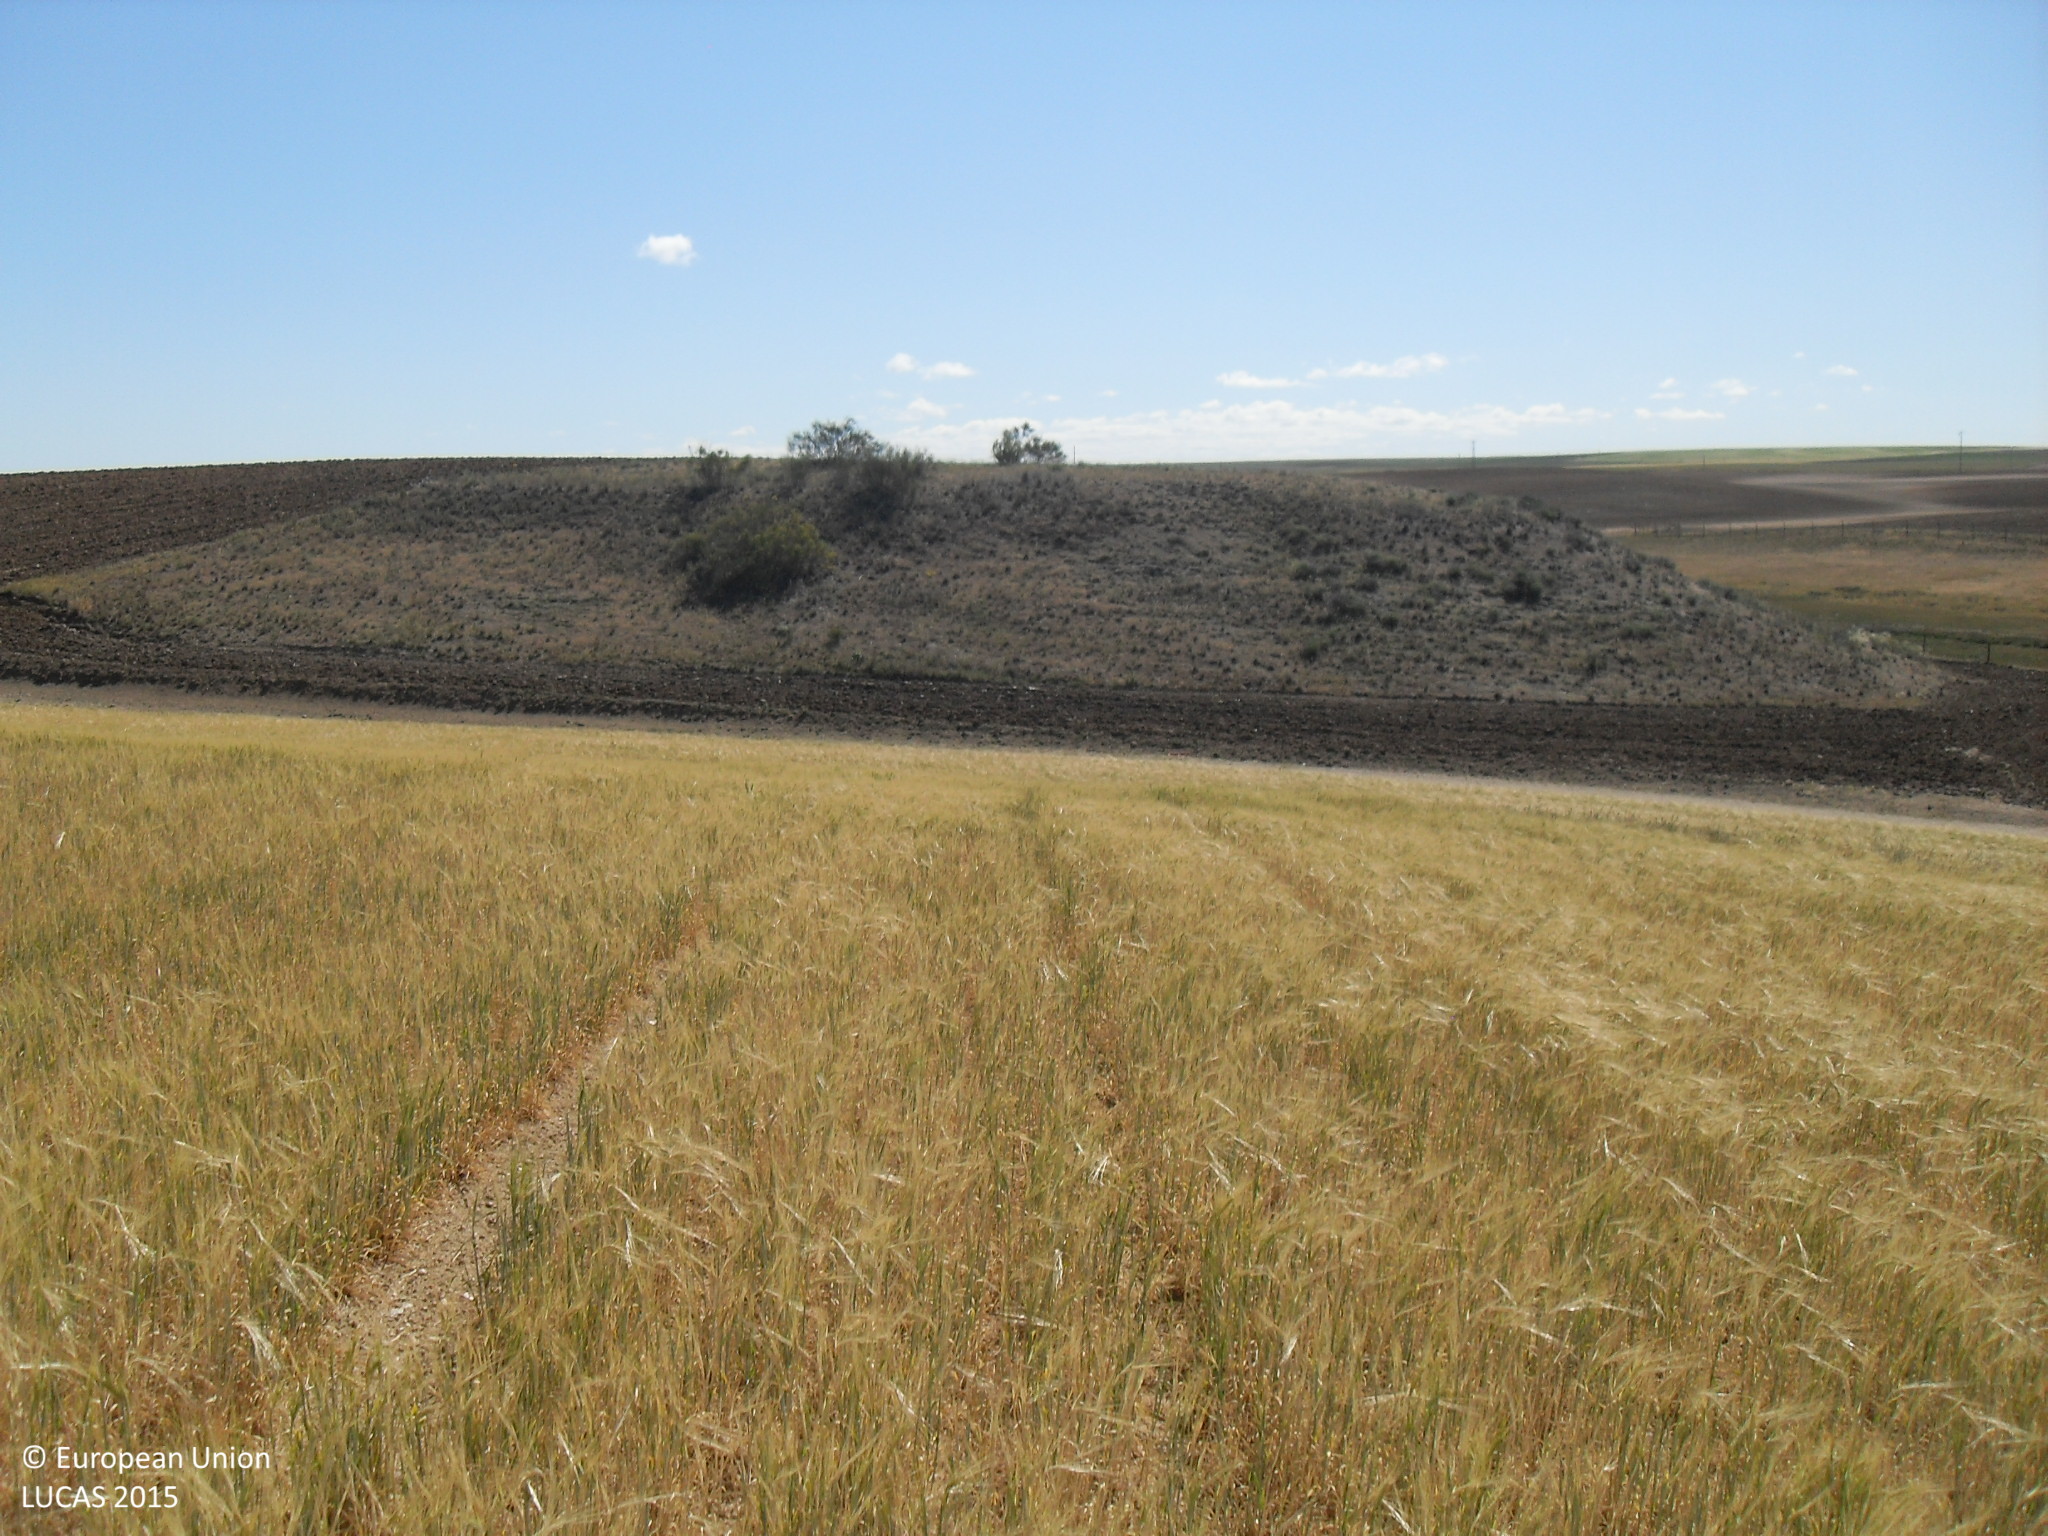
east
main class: Cropland
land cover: Barley
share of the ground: > 75 %
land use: Agriculture (excluding fallow land and kitchen gardens)
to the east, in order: Barley; Spontaneously vegetated surfaces; Barley; Grass margins; Tracks; Grass margins; Other bare soil; Spontaneously vegetated surfaces; Other bare soil; Grassland without tree/shrub cover; Inland fresh running water; Grassland without tree/shrub cover
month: May
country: ES
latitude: 41.1585
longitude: -5.2666
